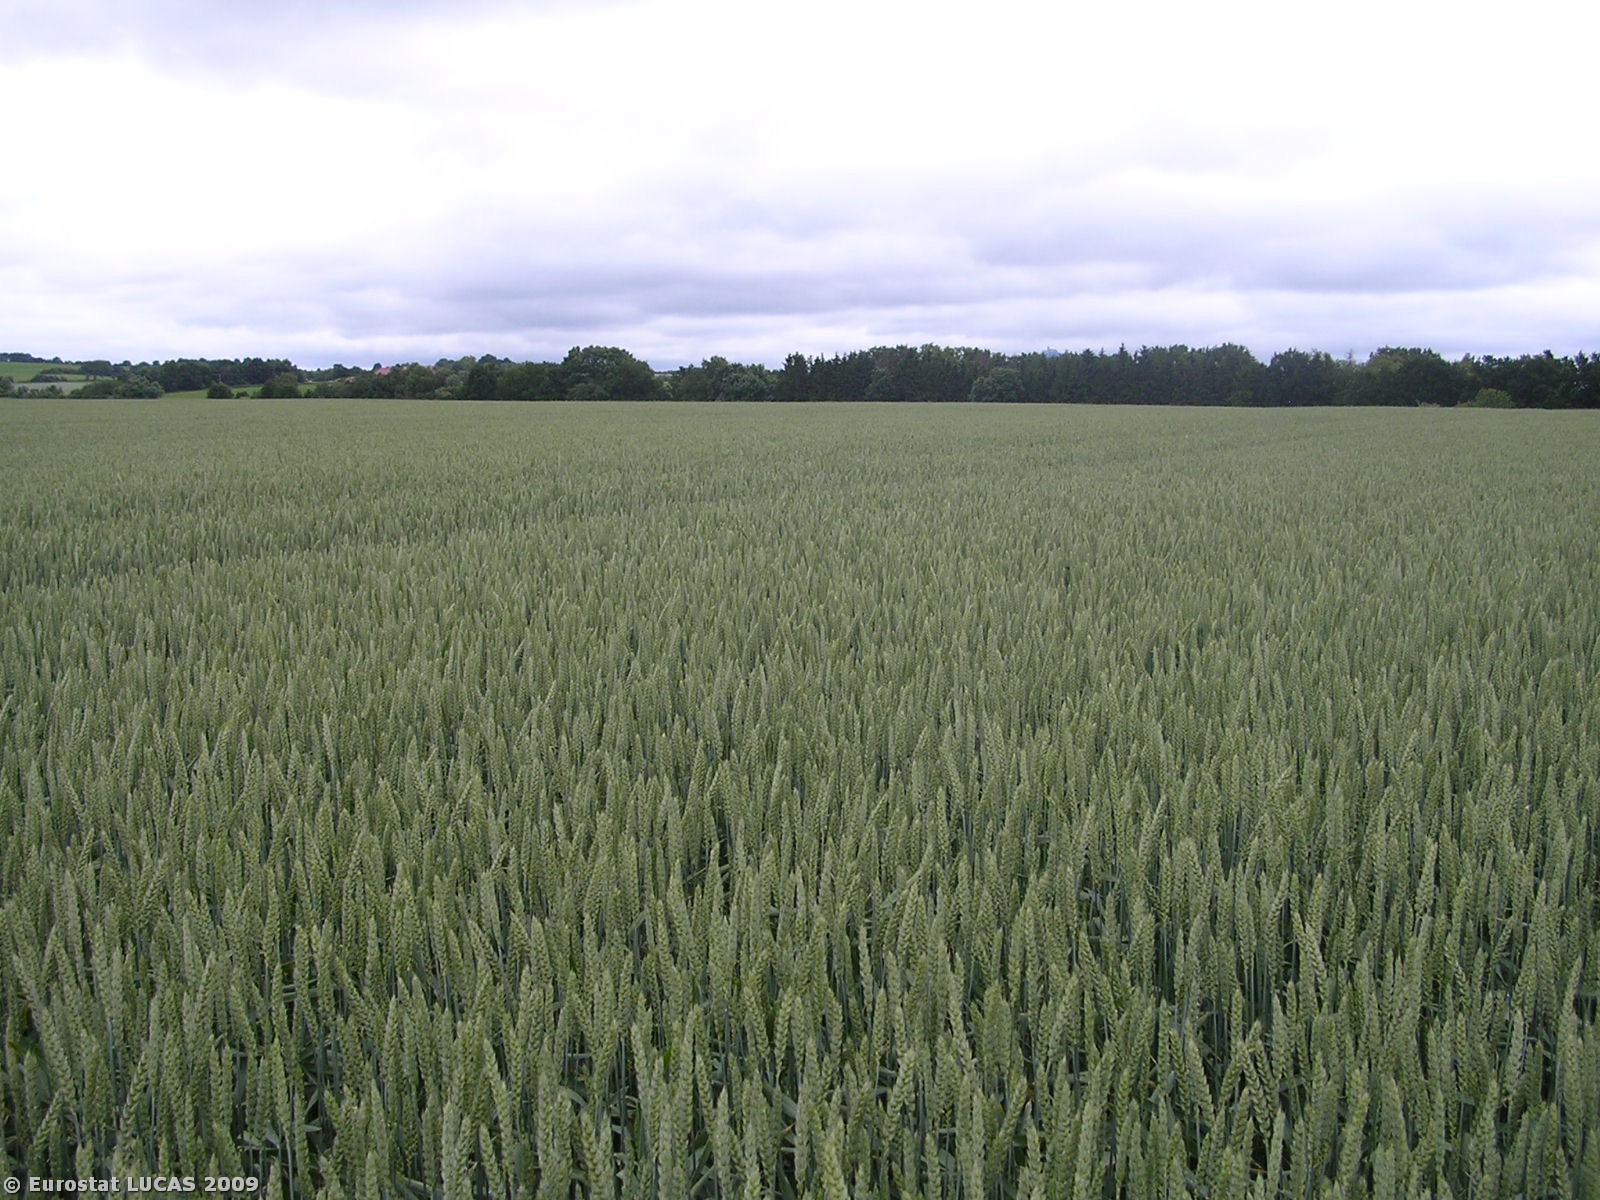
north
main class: Cropland
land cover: Common wheat
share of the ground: > 75 %
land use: Agriculture (excluding fallow land and kitchen gardens)
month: June
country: CZ
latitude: 50.4480
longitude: 14.6917
